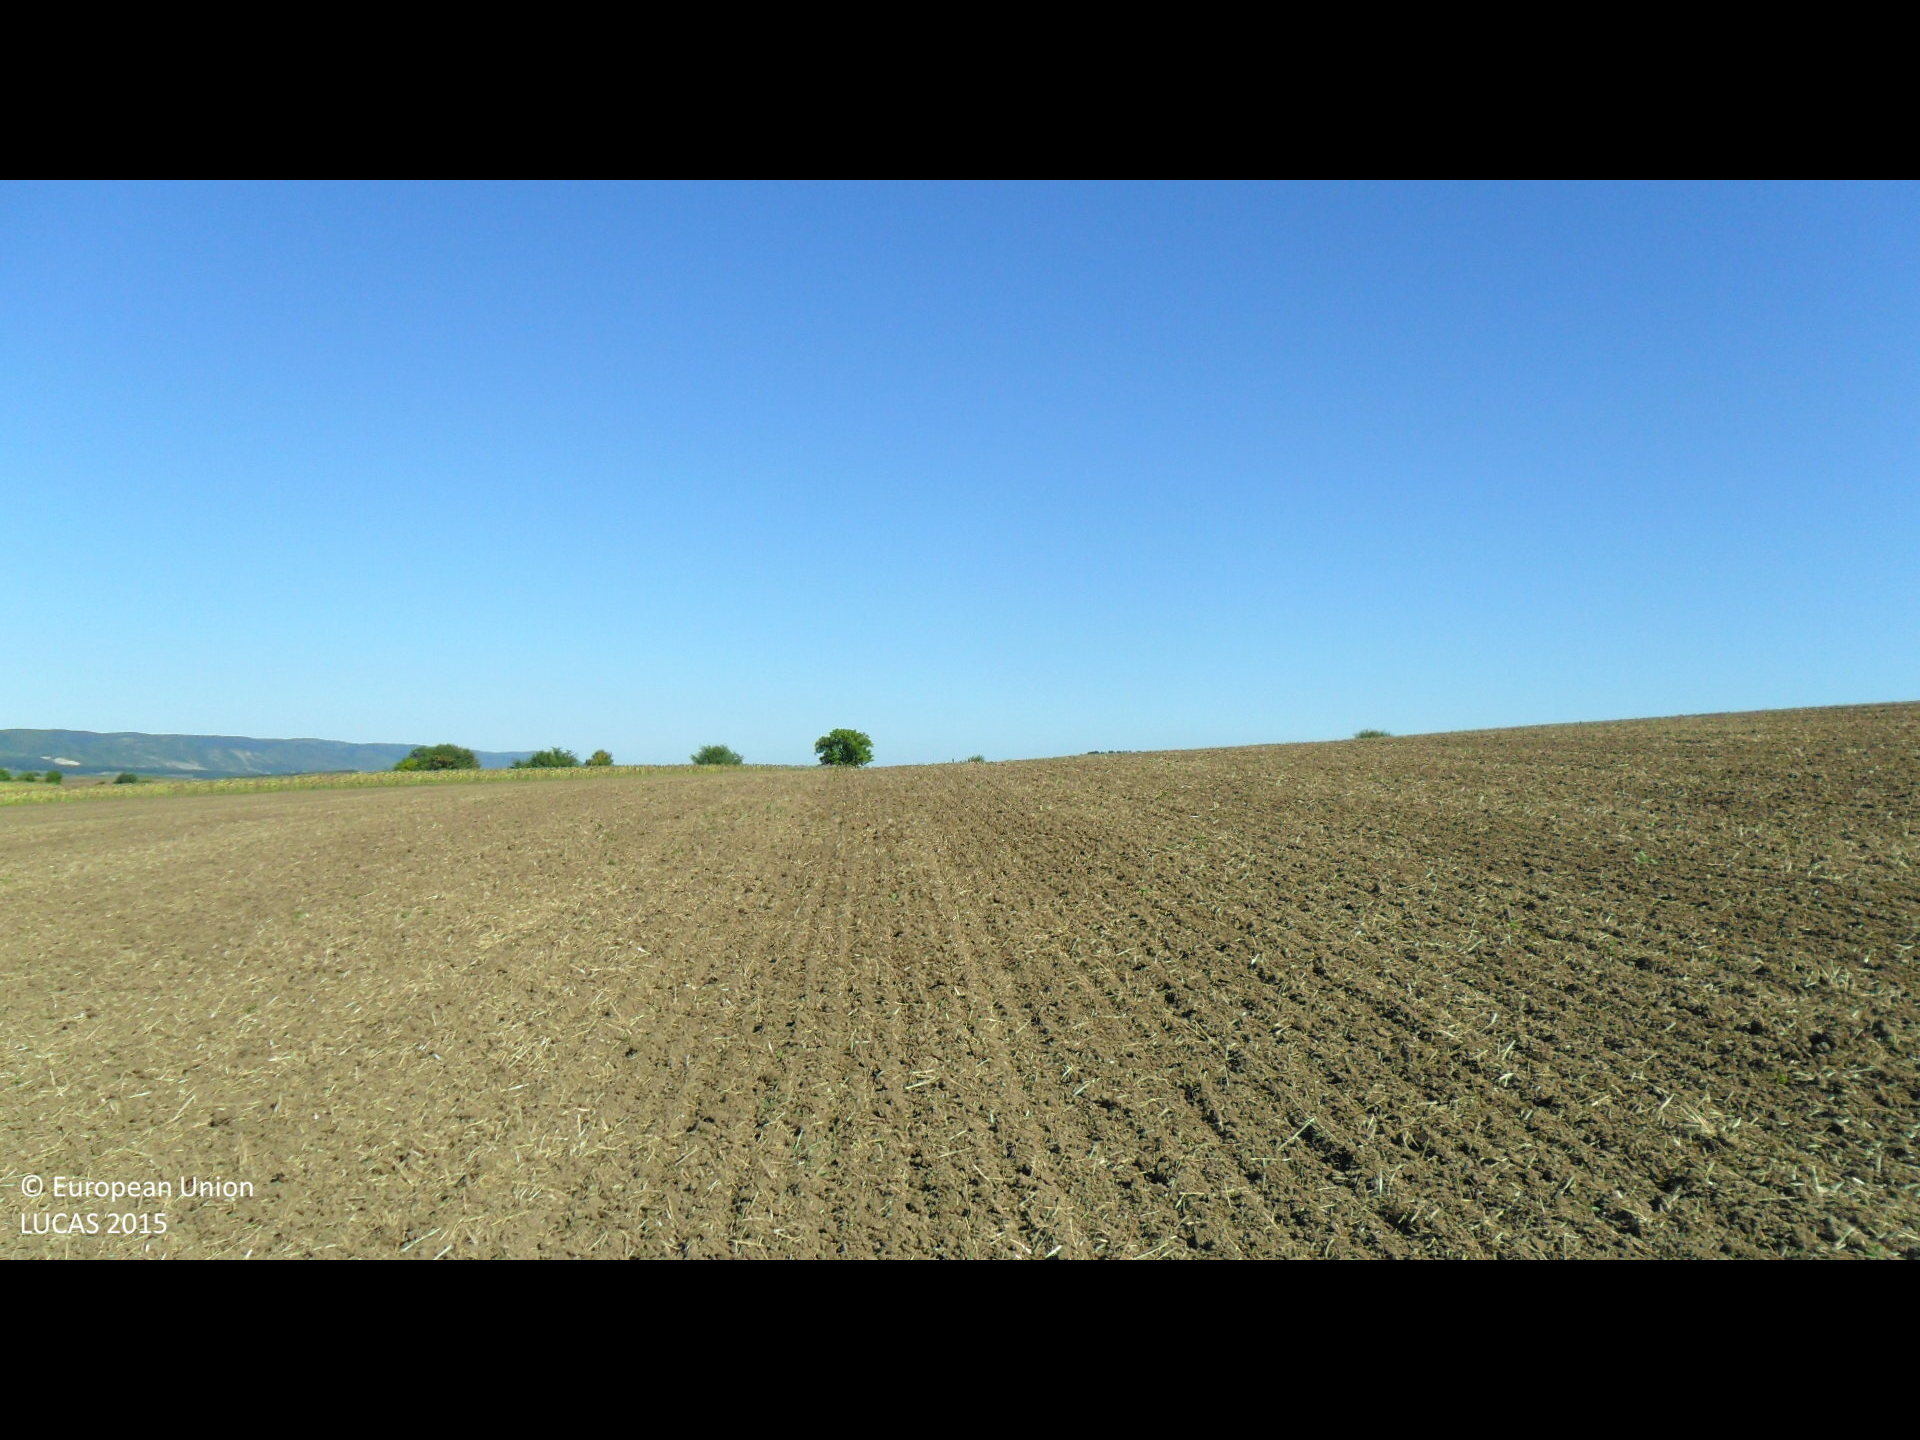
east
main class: Cropland
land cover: Common wheat
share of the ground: < 10 %
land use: Agriculture (excluding fallow land and kitchen gardens)
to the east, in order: Common wheat; Grass margins; Tracks; Grass margins; Sunflower
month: September
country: BG
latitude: 43.1351
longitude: 26.4623
